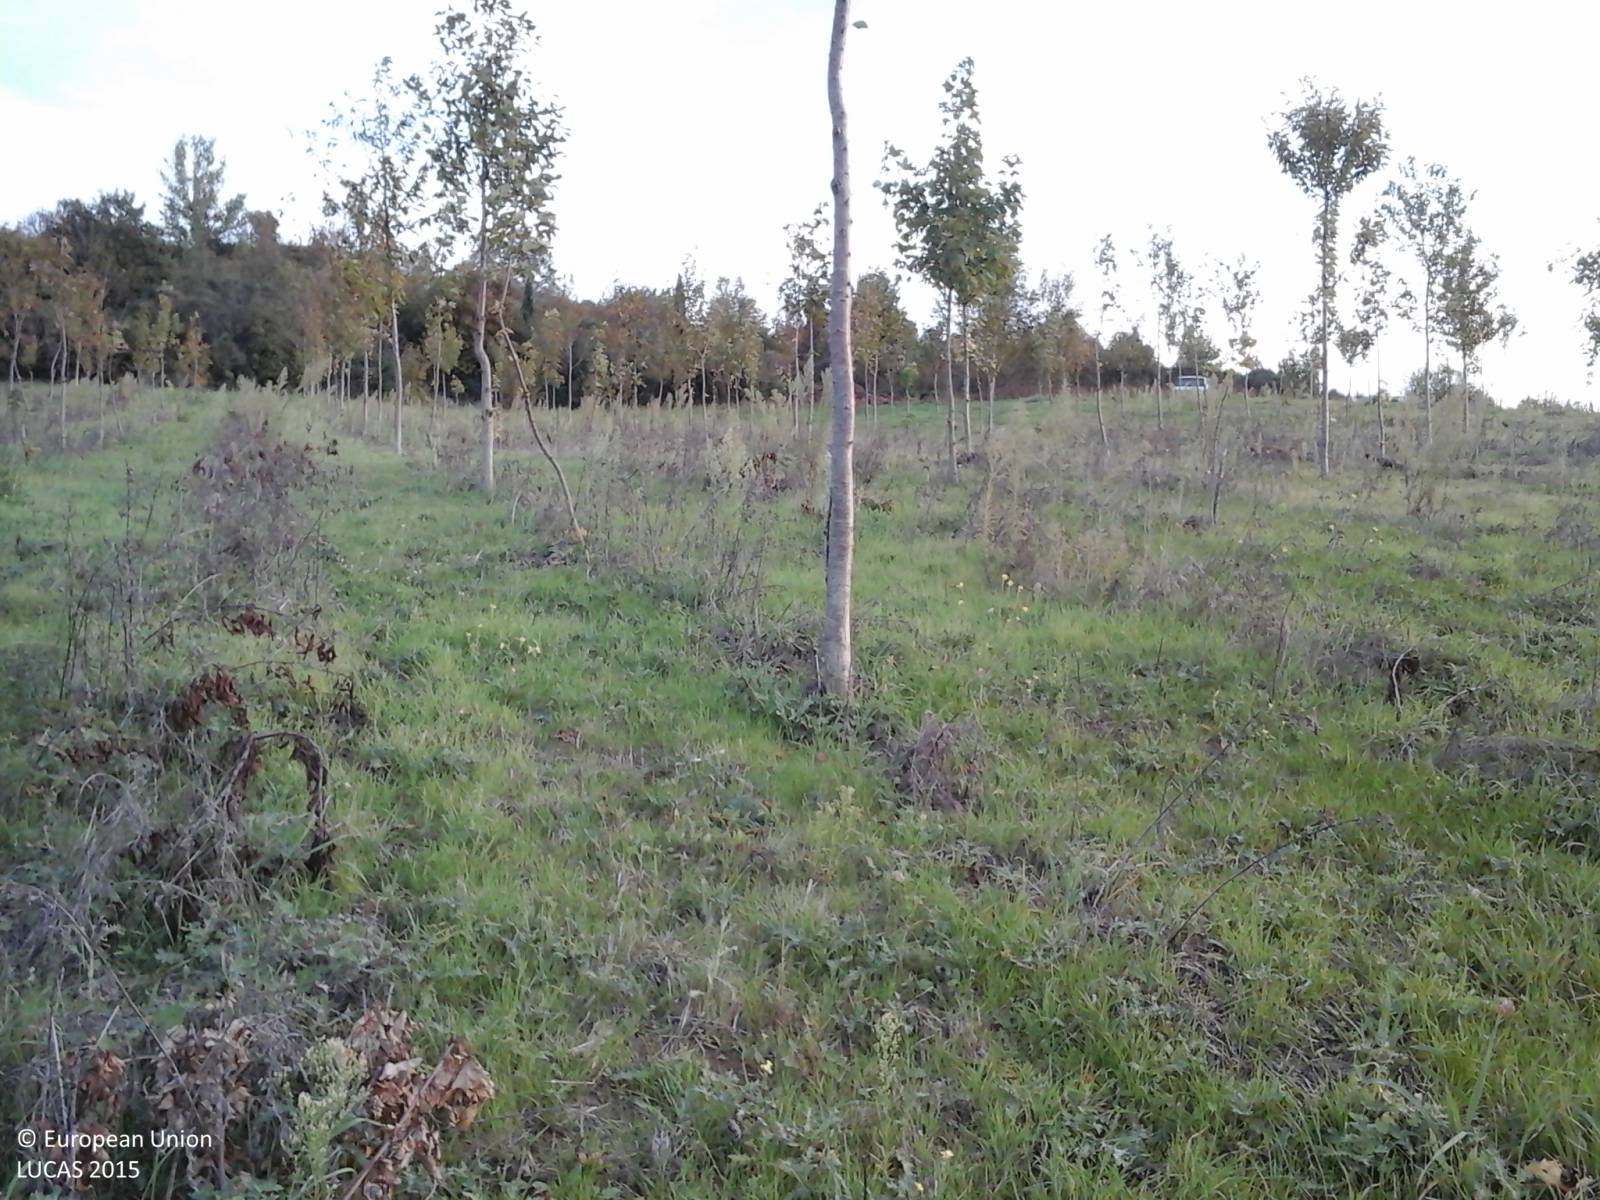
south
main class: Cropland
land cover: Cherry fruit
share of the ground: 50 - 75 %
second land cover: Spontaneously vegetated surfaces
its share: > 75 %
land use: Agriculture (excluding fallow land and kitchen gardens)
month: October
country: IT
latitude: 42.8085
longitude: 12.3041
